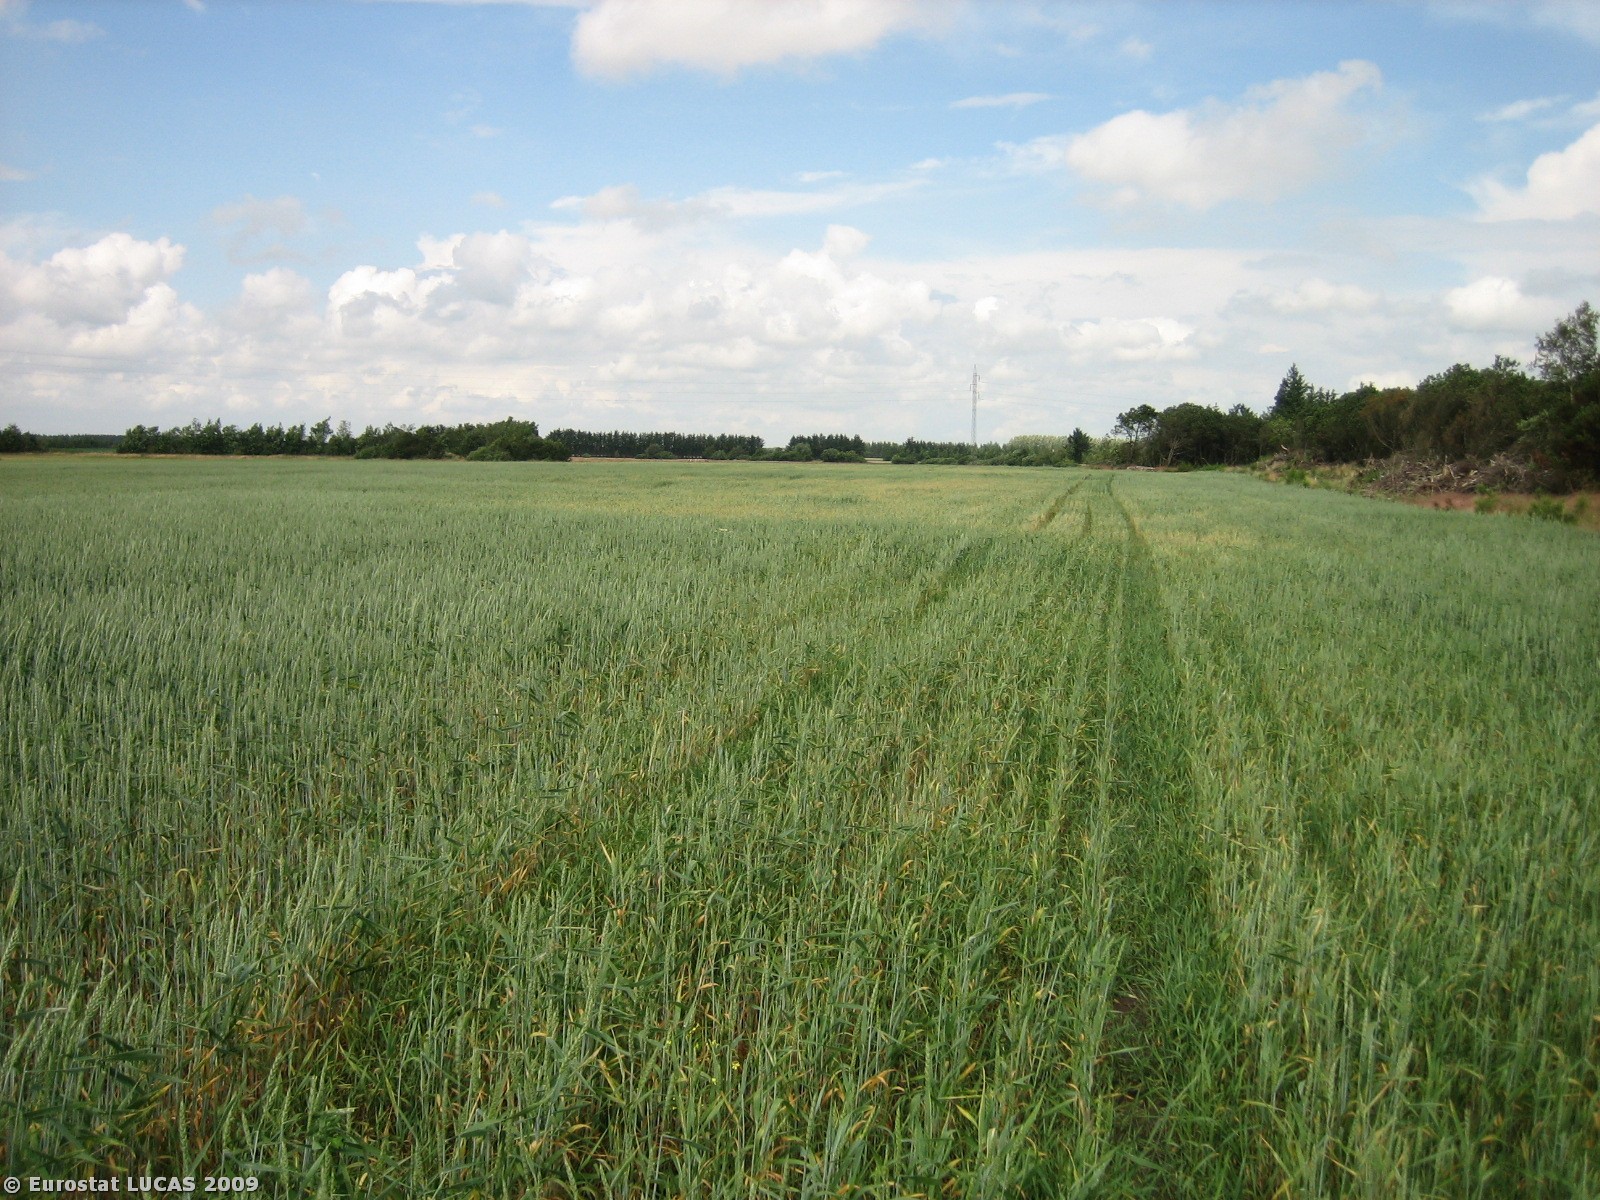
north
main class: Cropland
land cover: Triticale
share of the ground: > 75 %
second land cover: Spontaneously vegetated surfaces
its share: 50 - 75 %
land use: Agriculture (excluding fallow land and kitchen gardens)
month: July
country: DK
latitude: 55.6076
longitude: 8.8740
